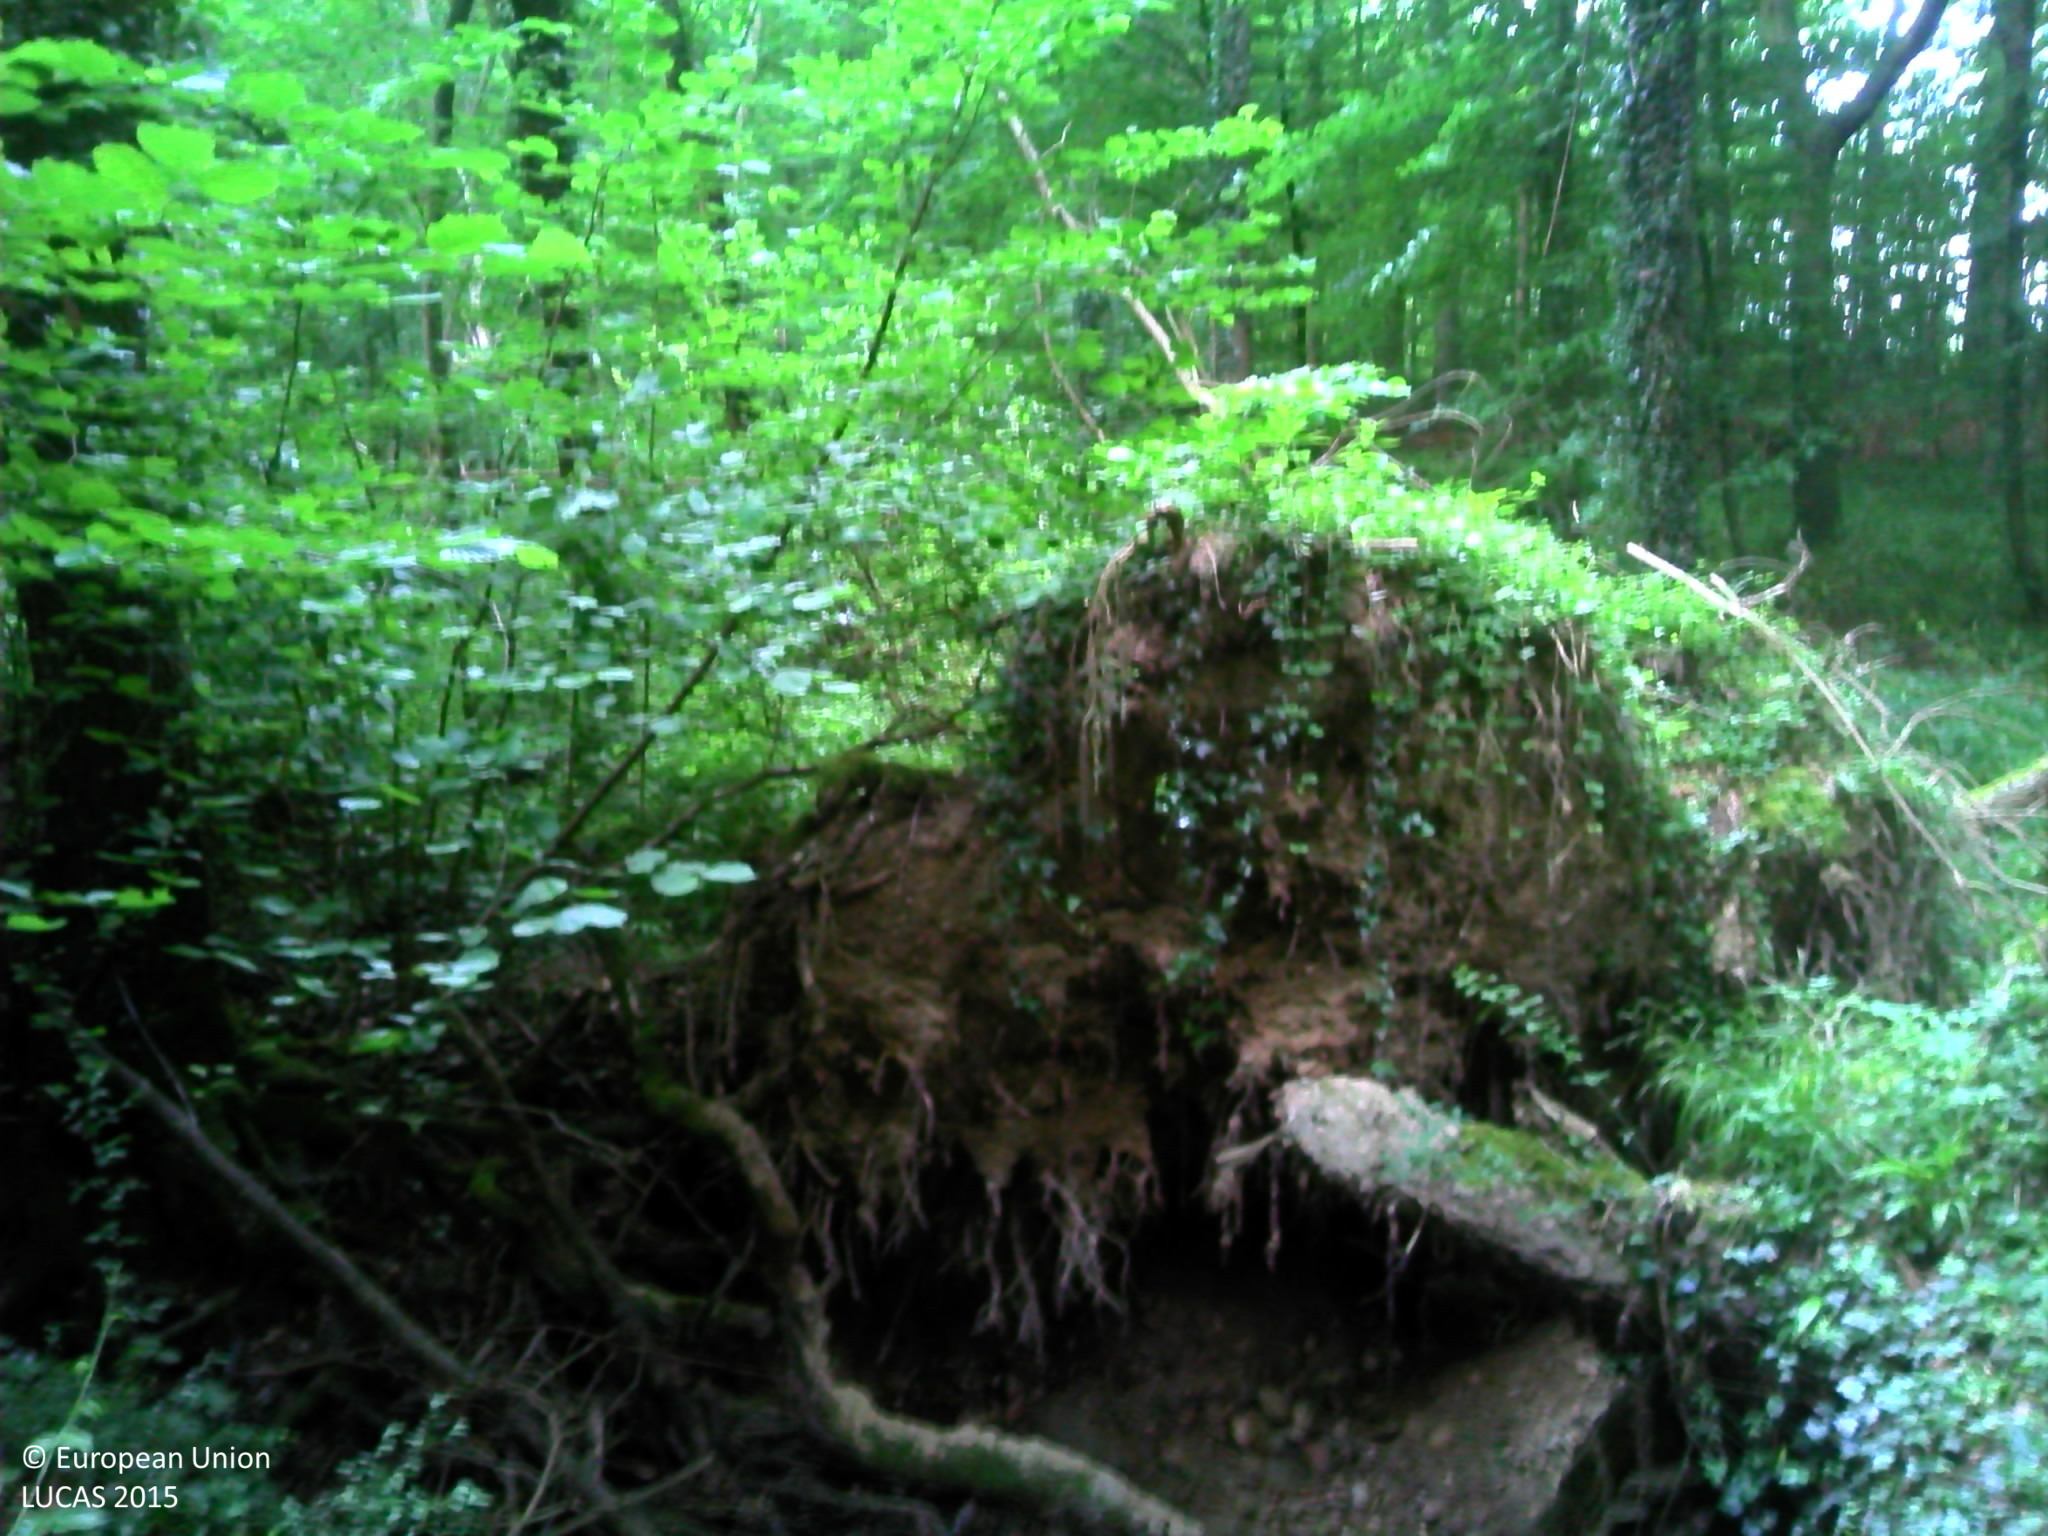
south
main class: Woodland
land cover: Broadleaved woodland
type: beech forest
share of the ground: > 75 %
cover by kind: broadleaved forest trees 95 %, herbaceous plants 5 %
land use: Forestry
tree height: > 5 m
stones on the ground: < 10 %
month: June
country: FR
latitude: 47.6162
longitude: 7.3806
